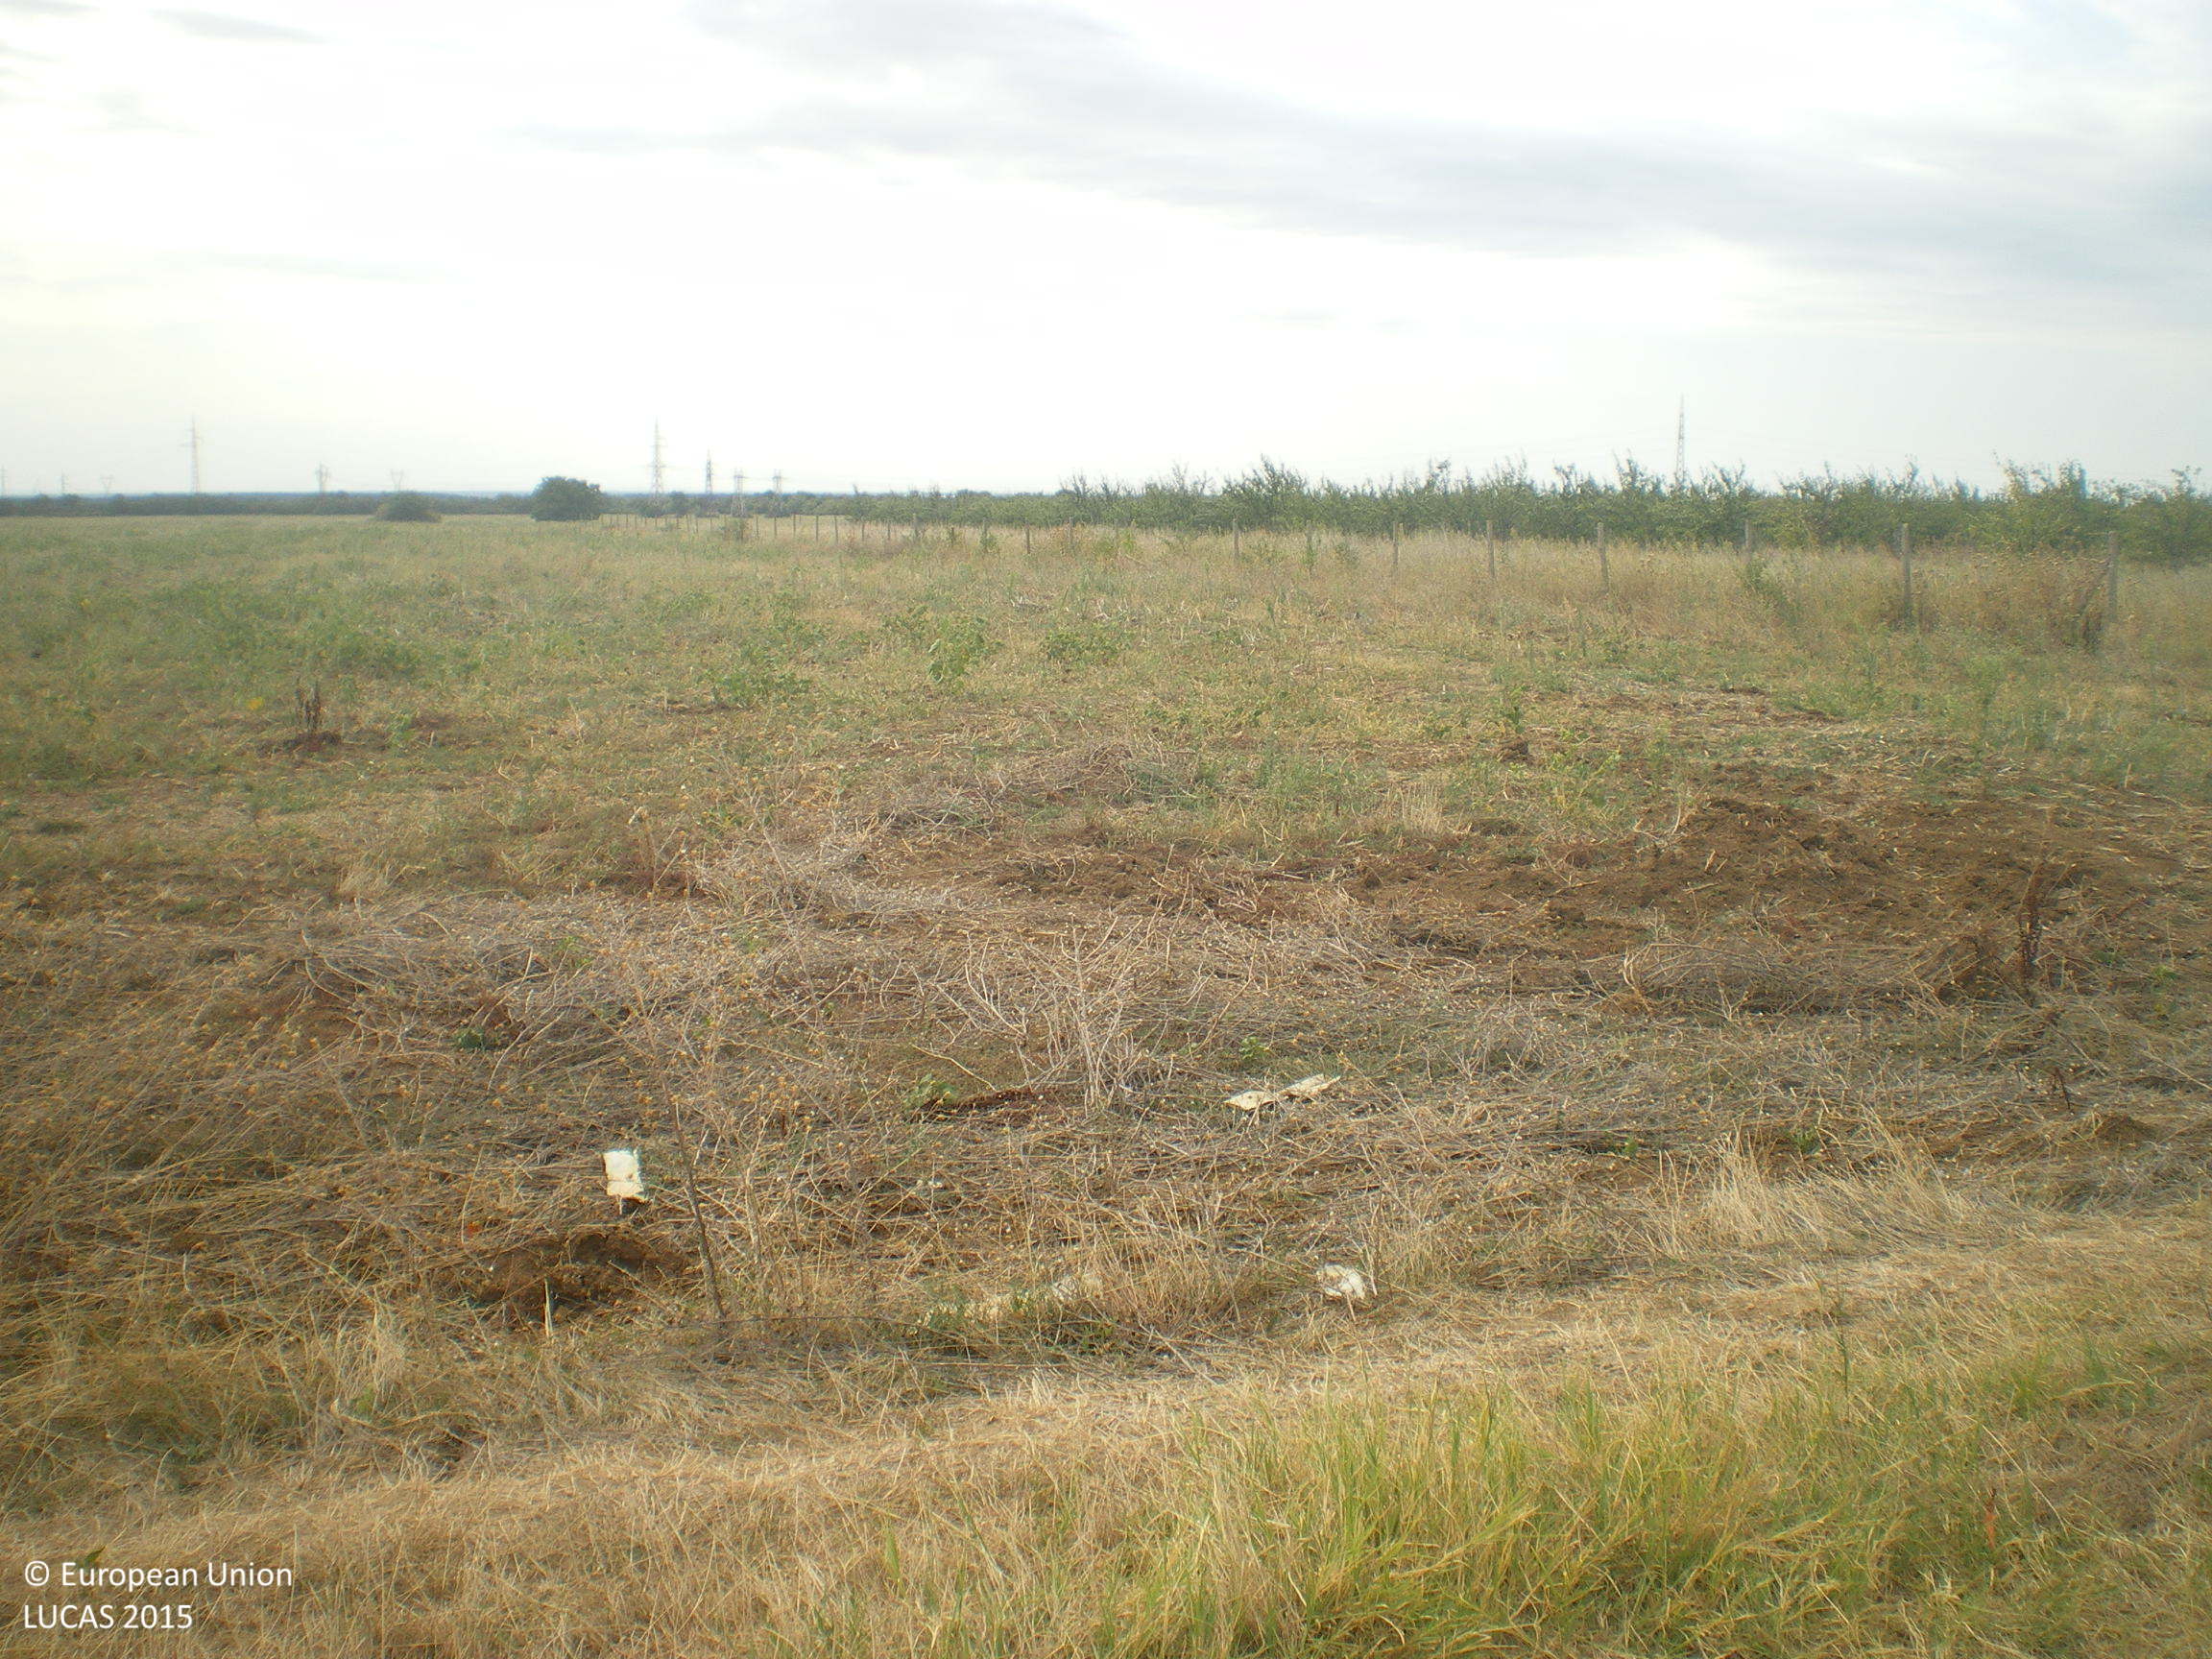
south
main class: Cropland
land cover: Vineyards
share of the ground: > 75 %
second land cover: Shrubland without tree cover
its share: > 75 %
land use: Abandoned areas
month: September
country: BG
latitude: 42.4595
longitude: 25.7500
